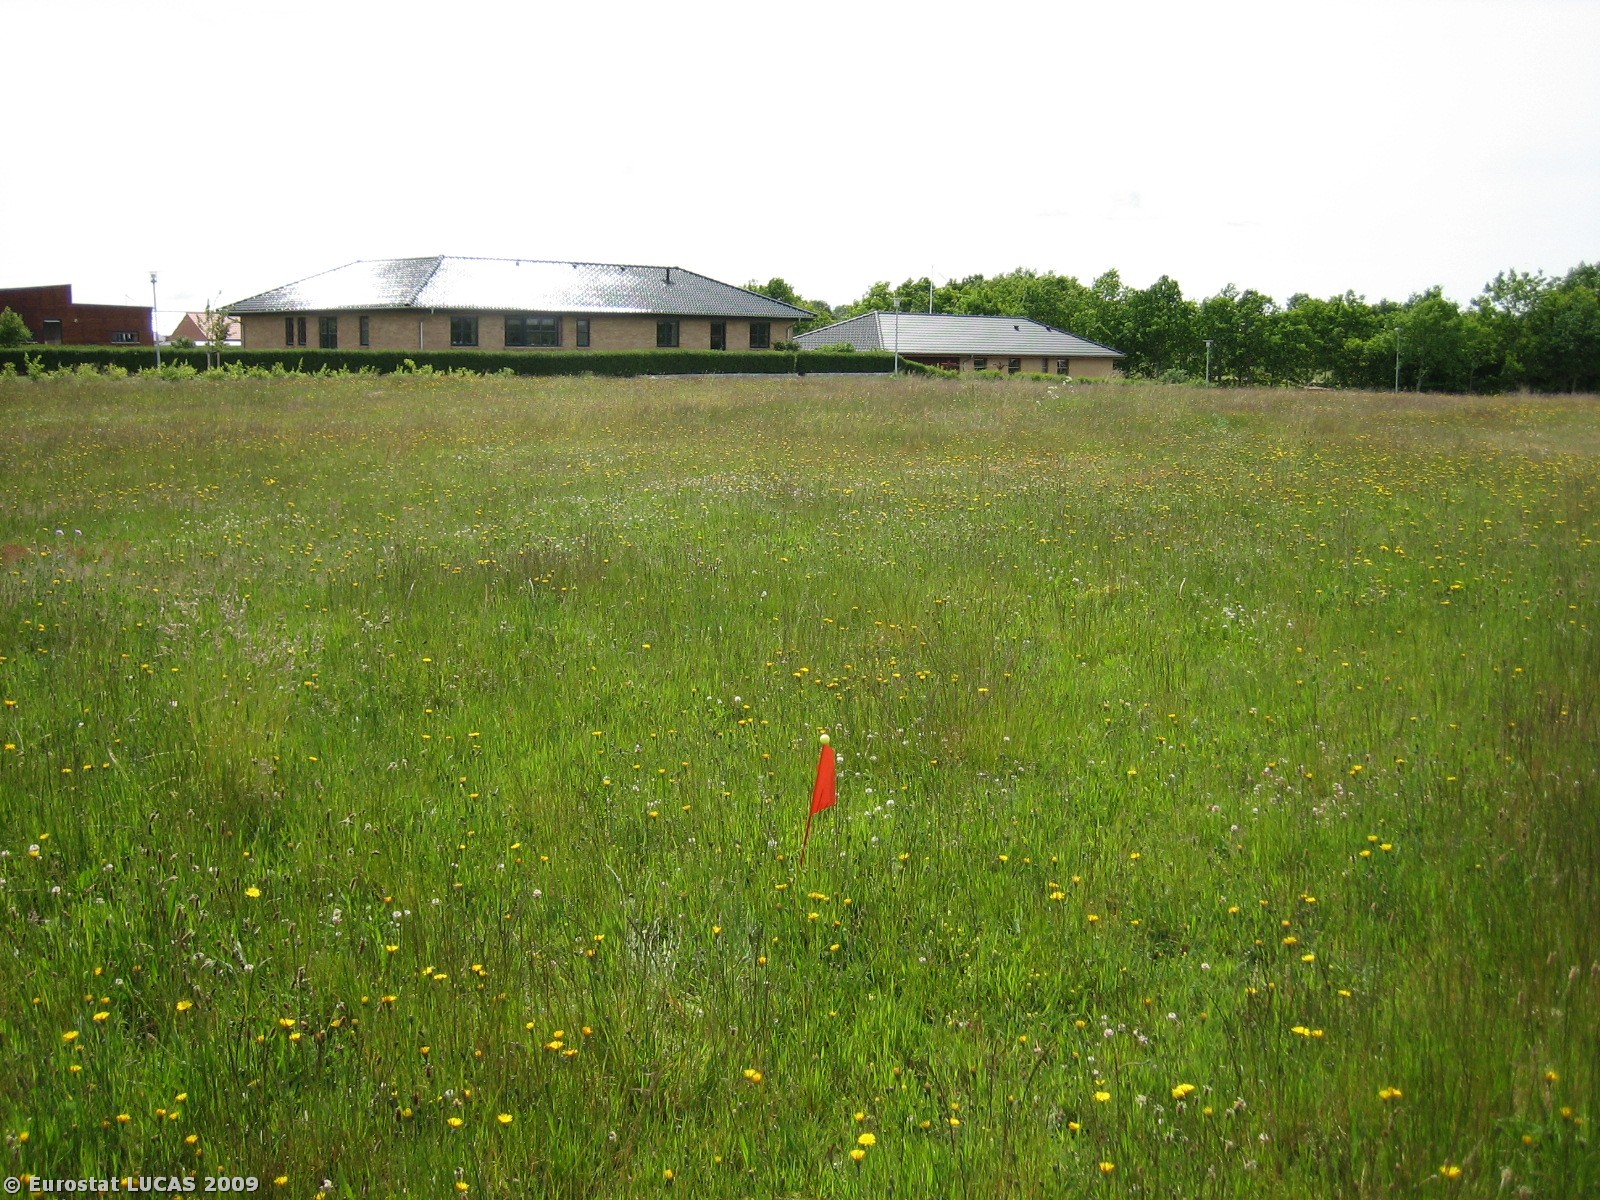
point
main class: Grassland
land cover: Grassland without tree/shrub cover
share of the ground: > 75 %
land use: Unused
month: June
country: DK
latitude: 56.1874
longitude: 9.6942
